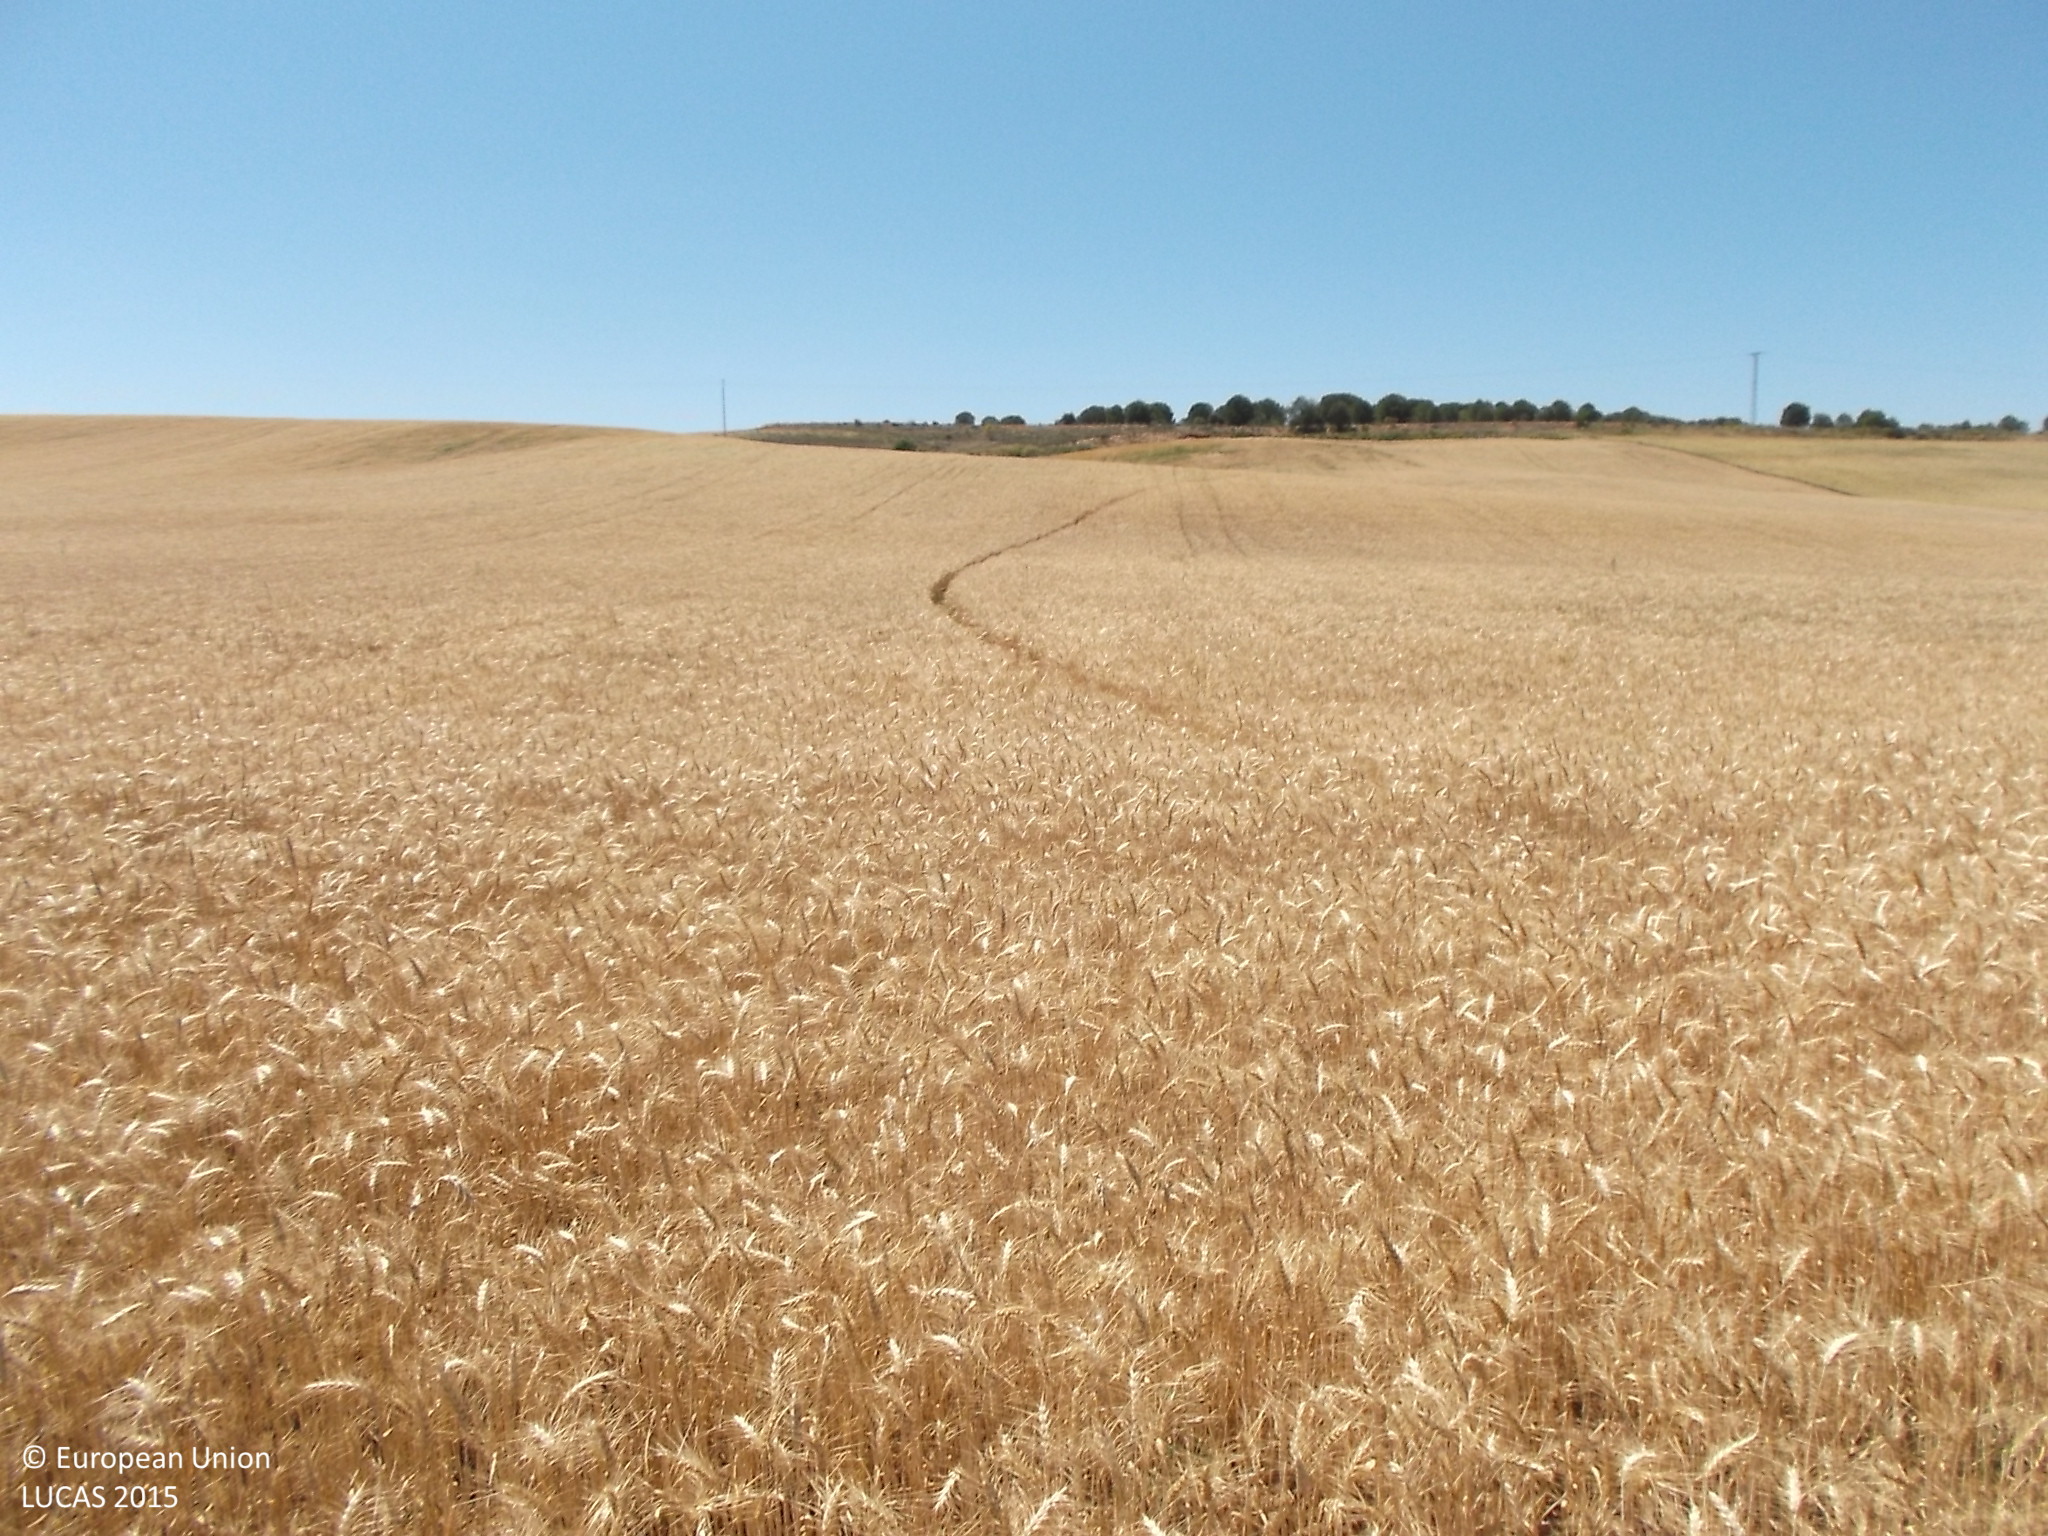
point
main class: Cropland
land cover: Common wheat
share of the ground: > 75 %
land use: Agriculture (excluding fallow land and kitchen gardens)
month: June
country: ES
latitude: 41.4411
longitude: -5.3376
